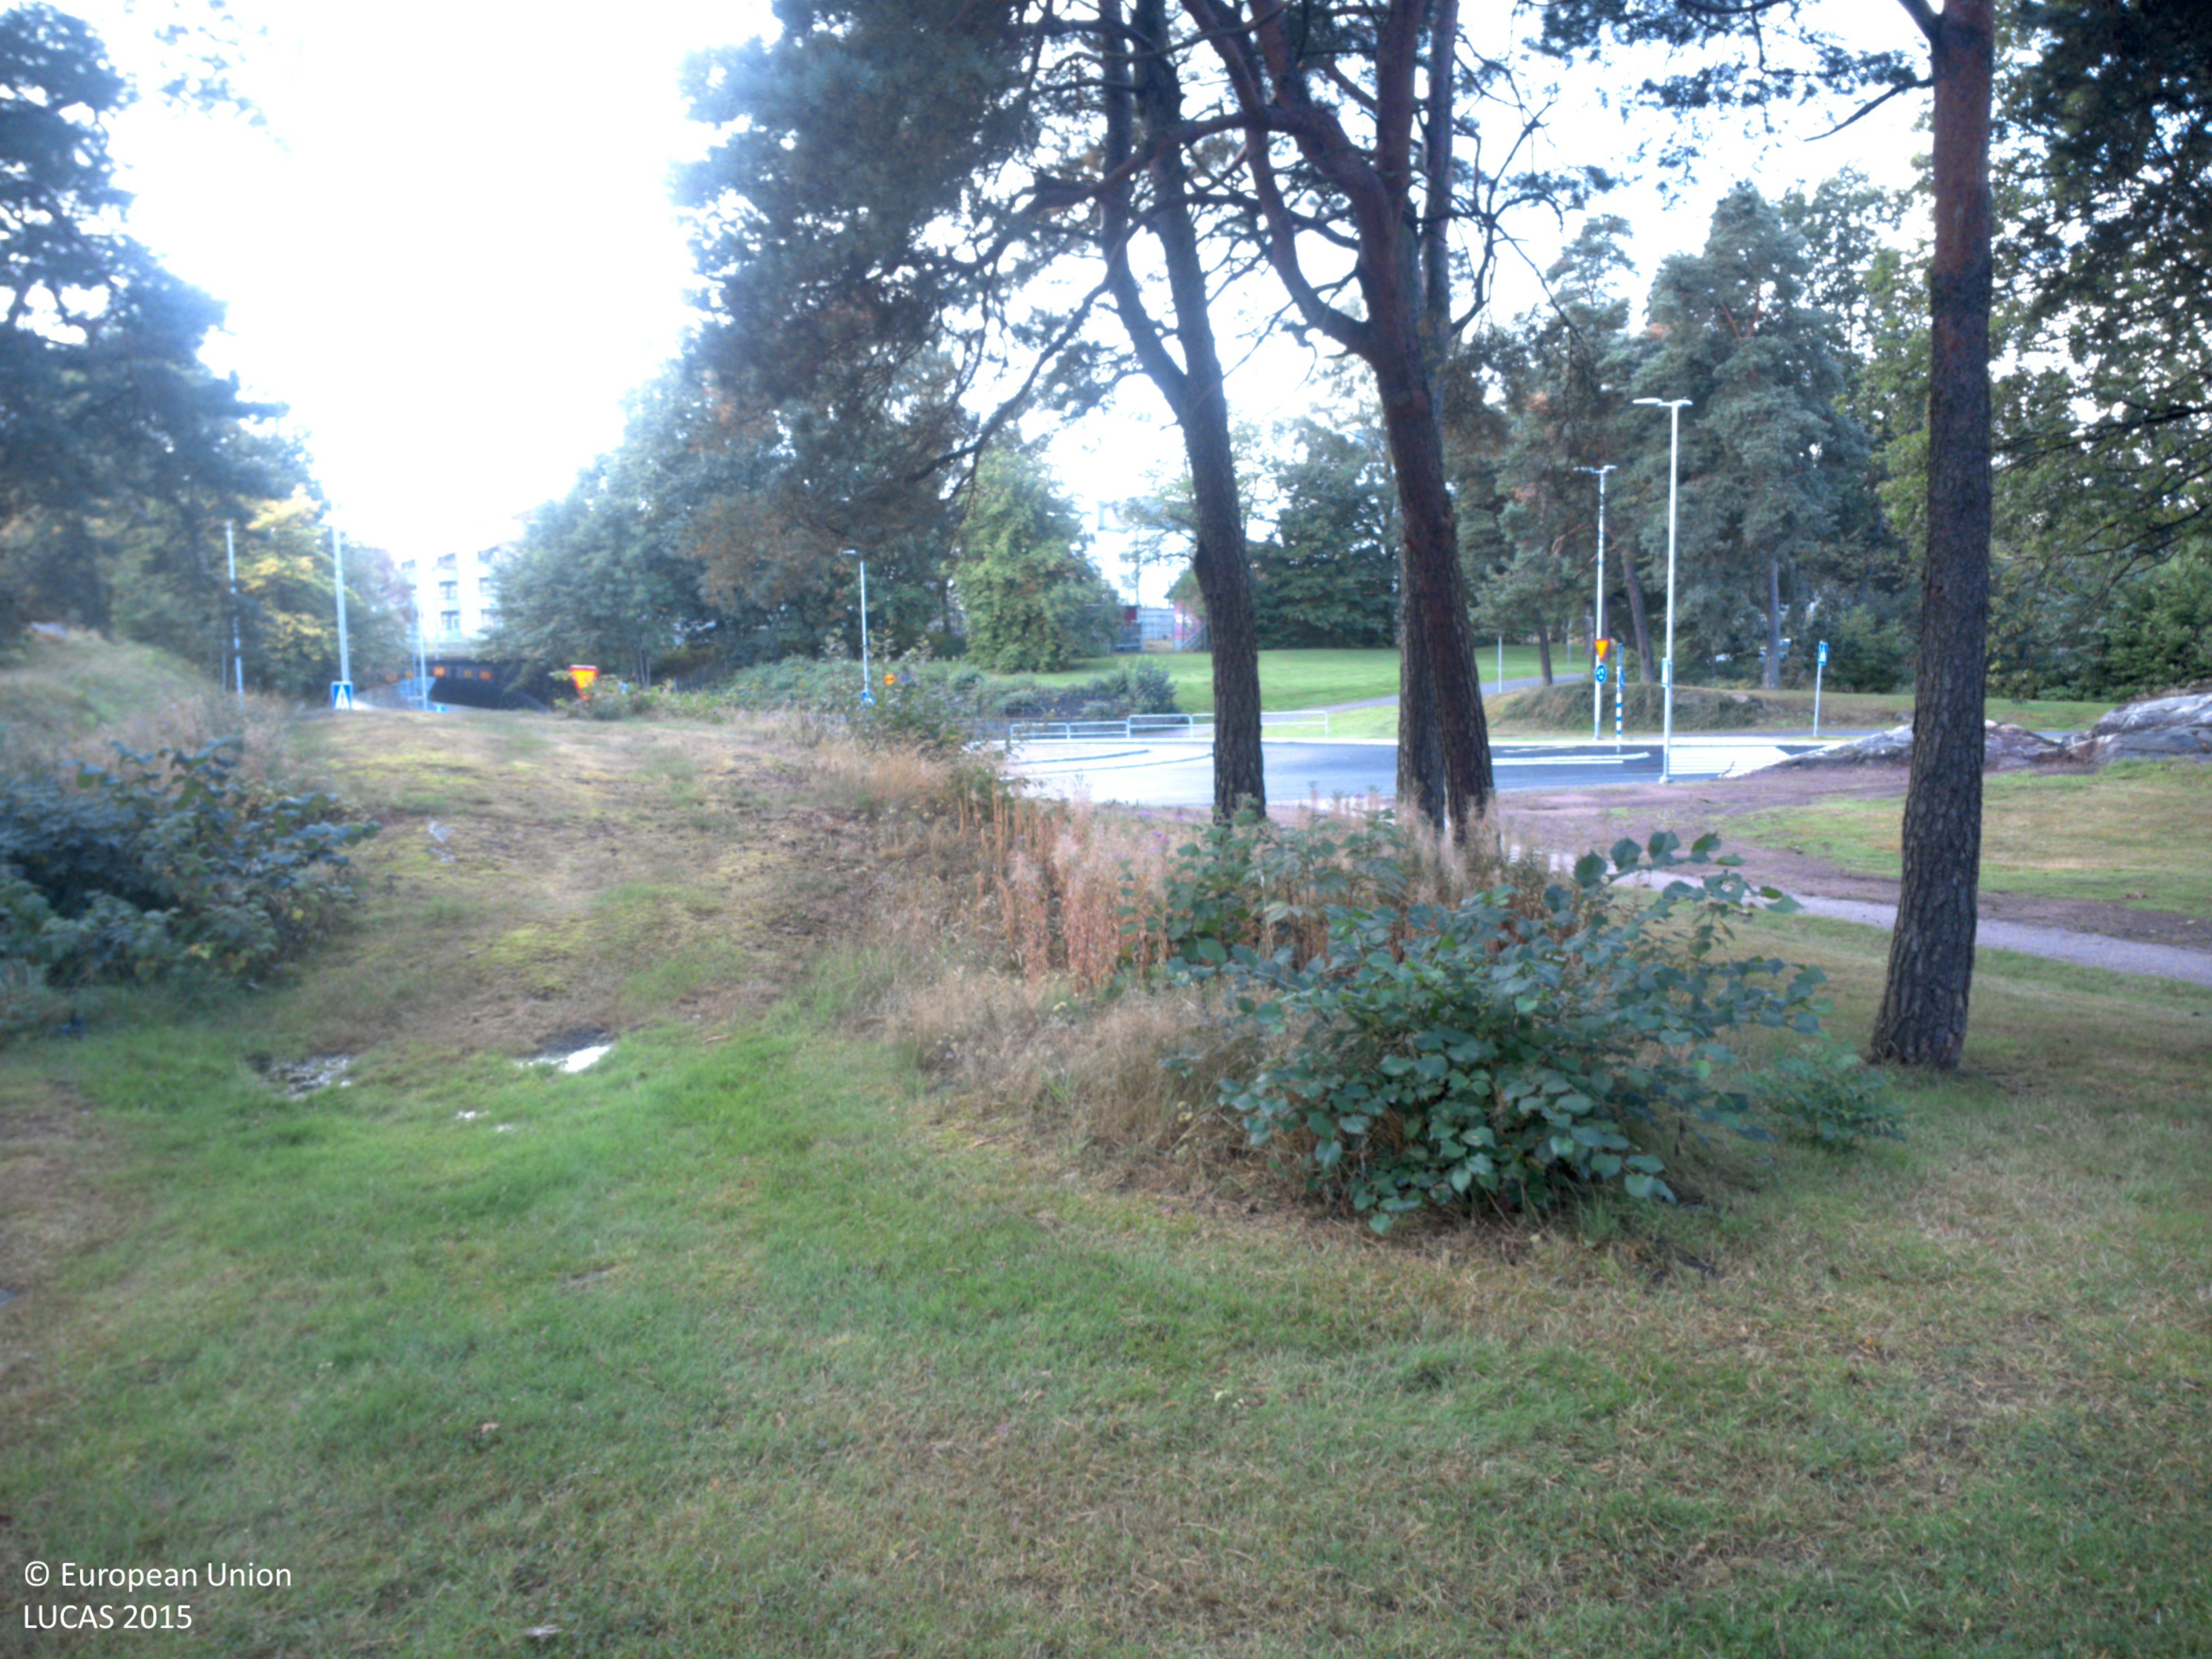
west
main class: Woodland
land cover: Pine dominated coniferous woodland
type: boreal forest
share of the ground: 50 - 75 %
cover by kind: coniferous forest trees 60 %, herbaceous plants 40 %
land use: Amenities, museums, leisure
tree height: > 5 m
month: August
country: SE
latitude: 58.2898
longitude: 12.2983
